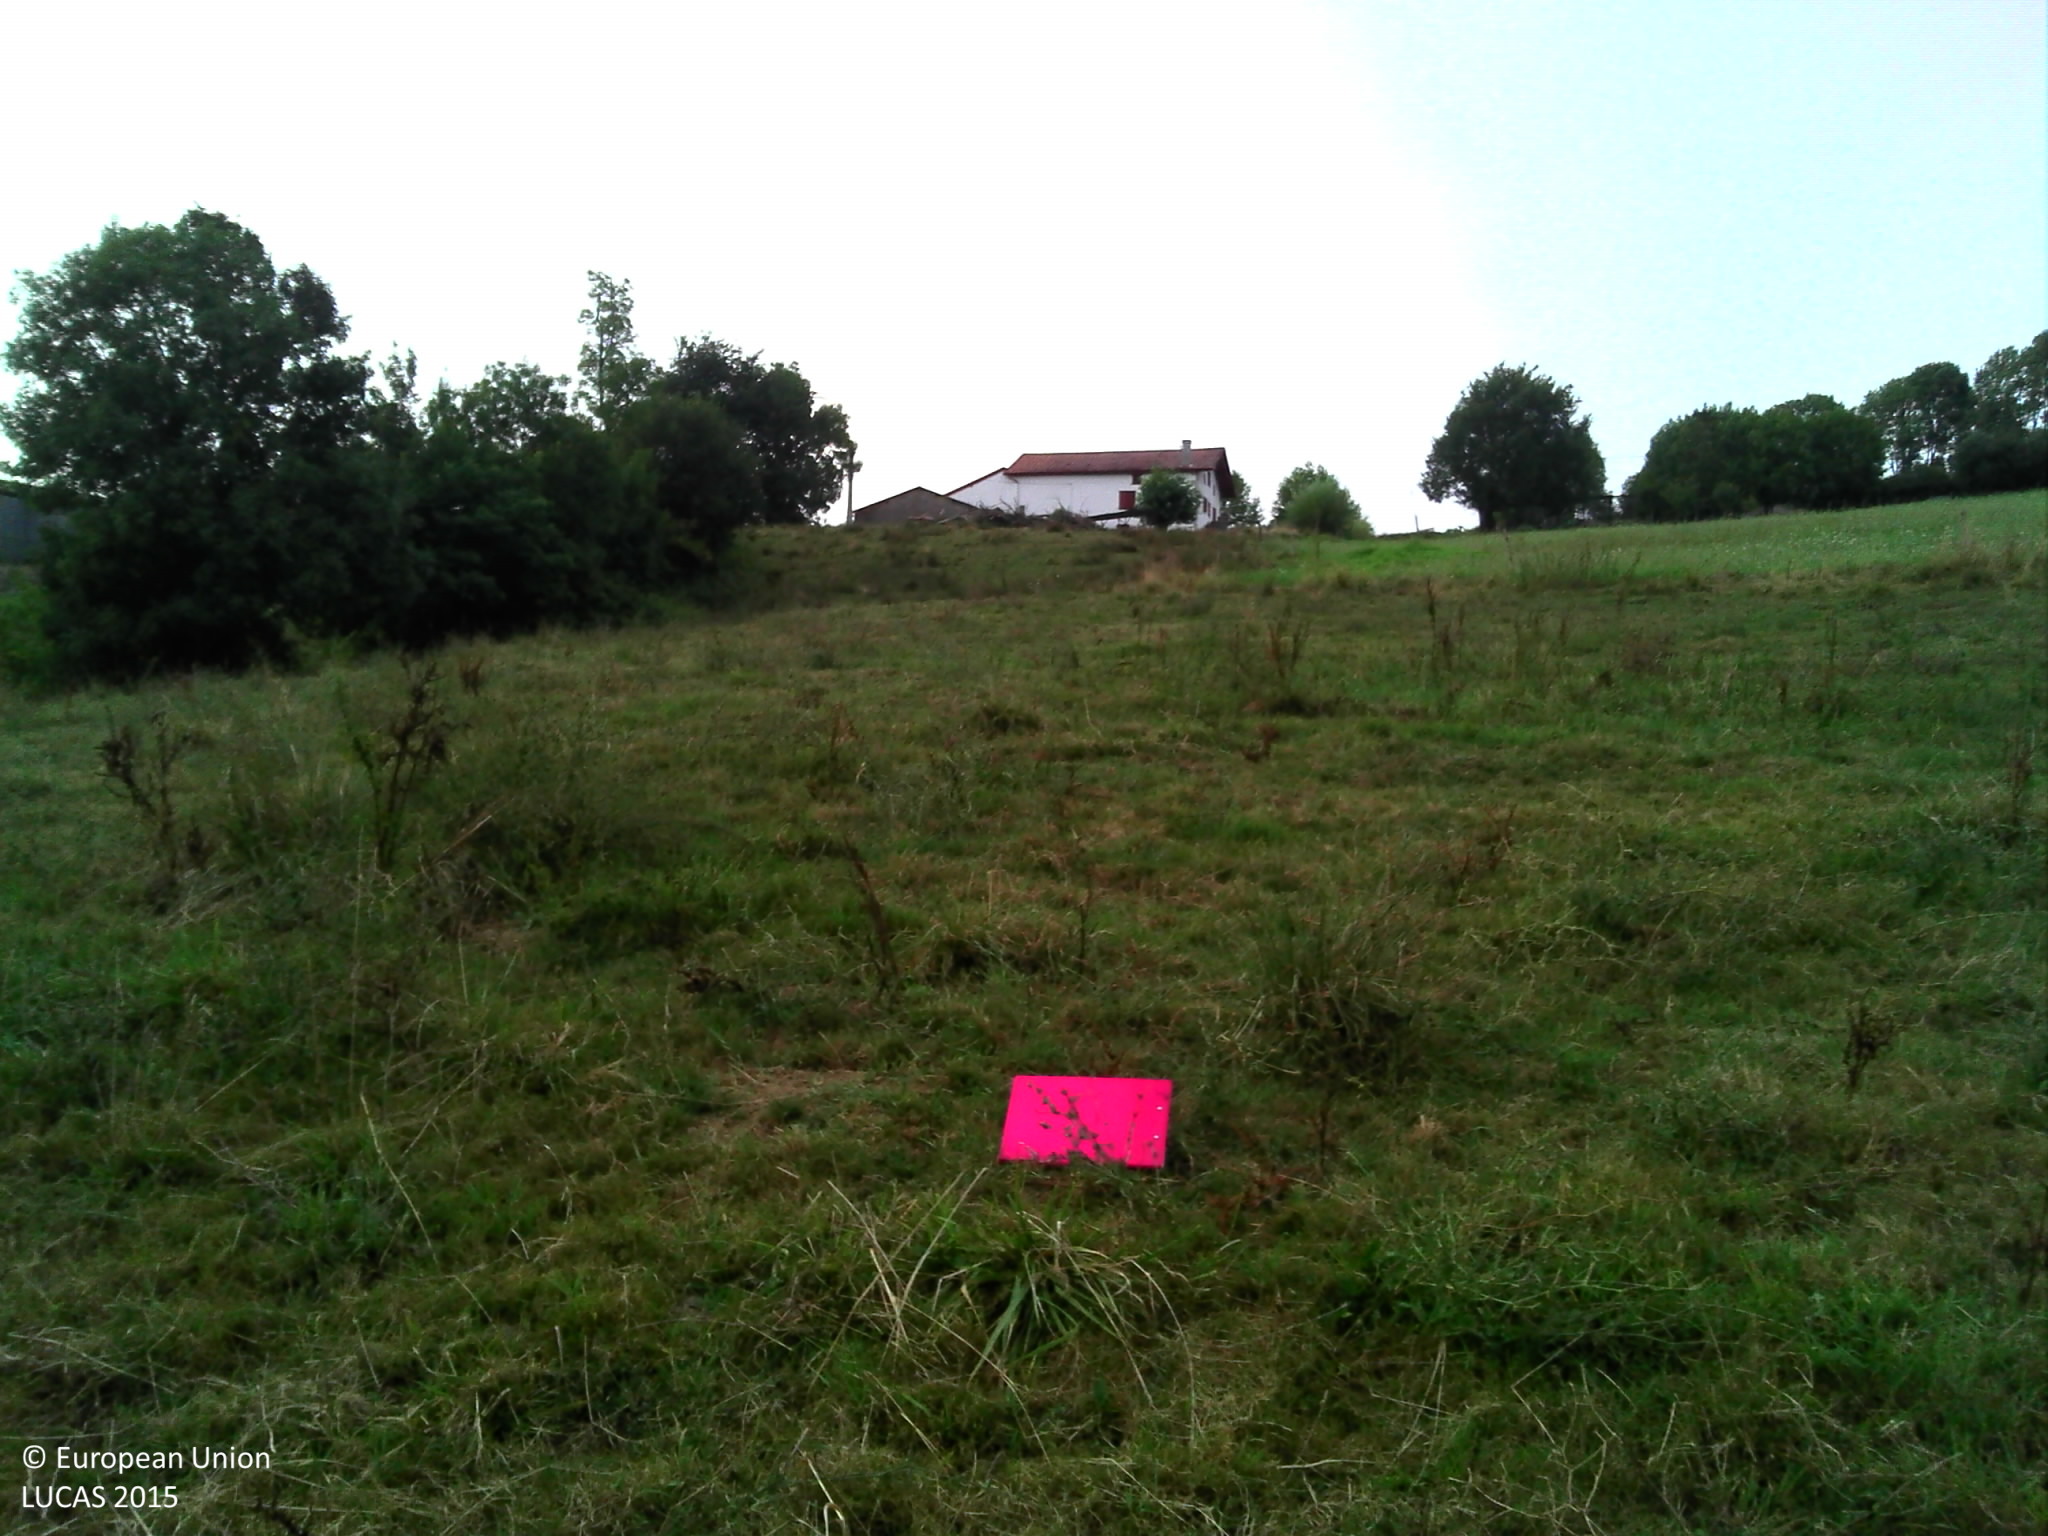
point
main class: Grassland
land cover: Grassland without tree/shrub cover
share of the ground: > 75 %
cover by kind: herbaceous plants 100 %
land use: Agriculture (excluding fallow land and kitchen gardens)
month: August
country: FR
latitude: 43.3951
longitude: -1.2128
